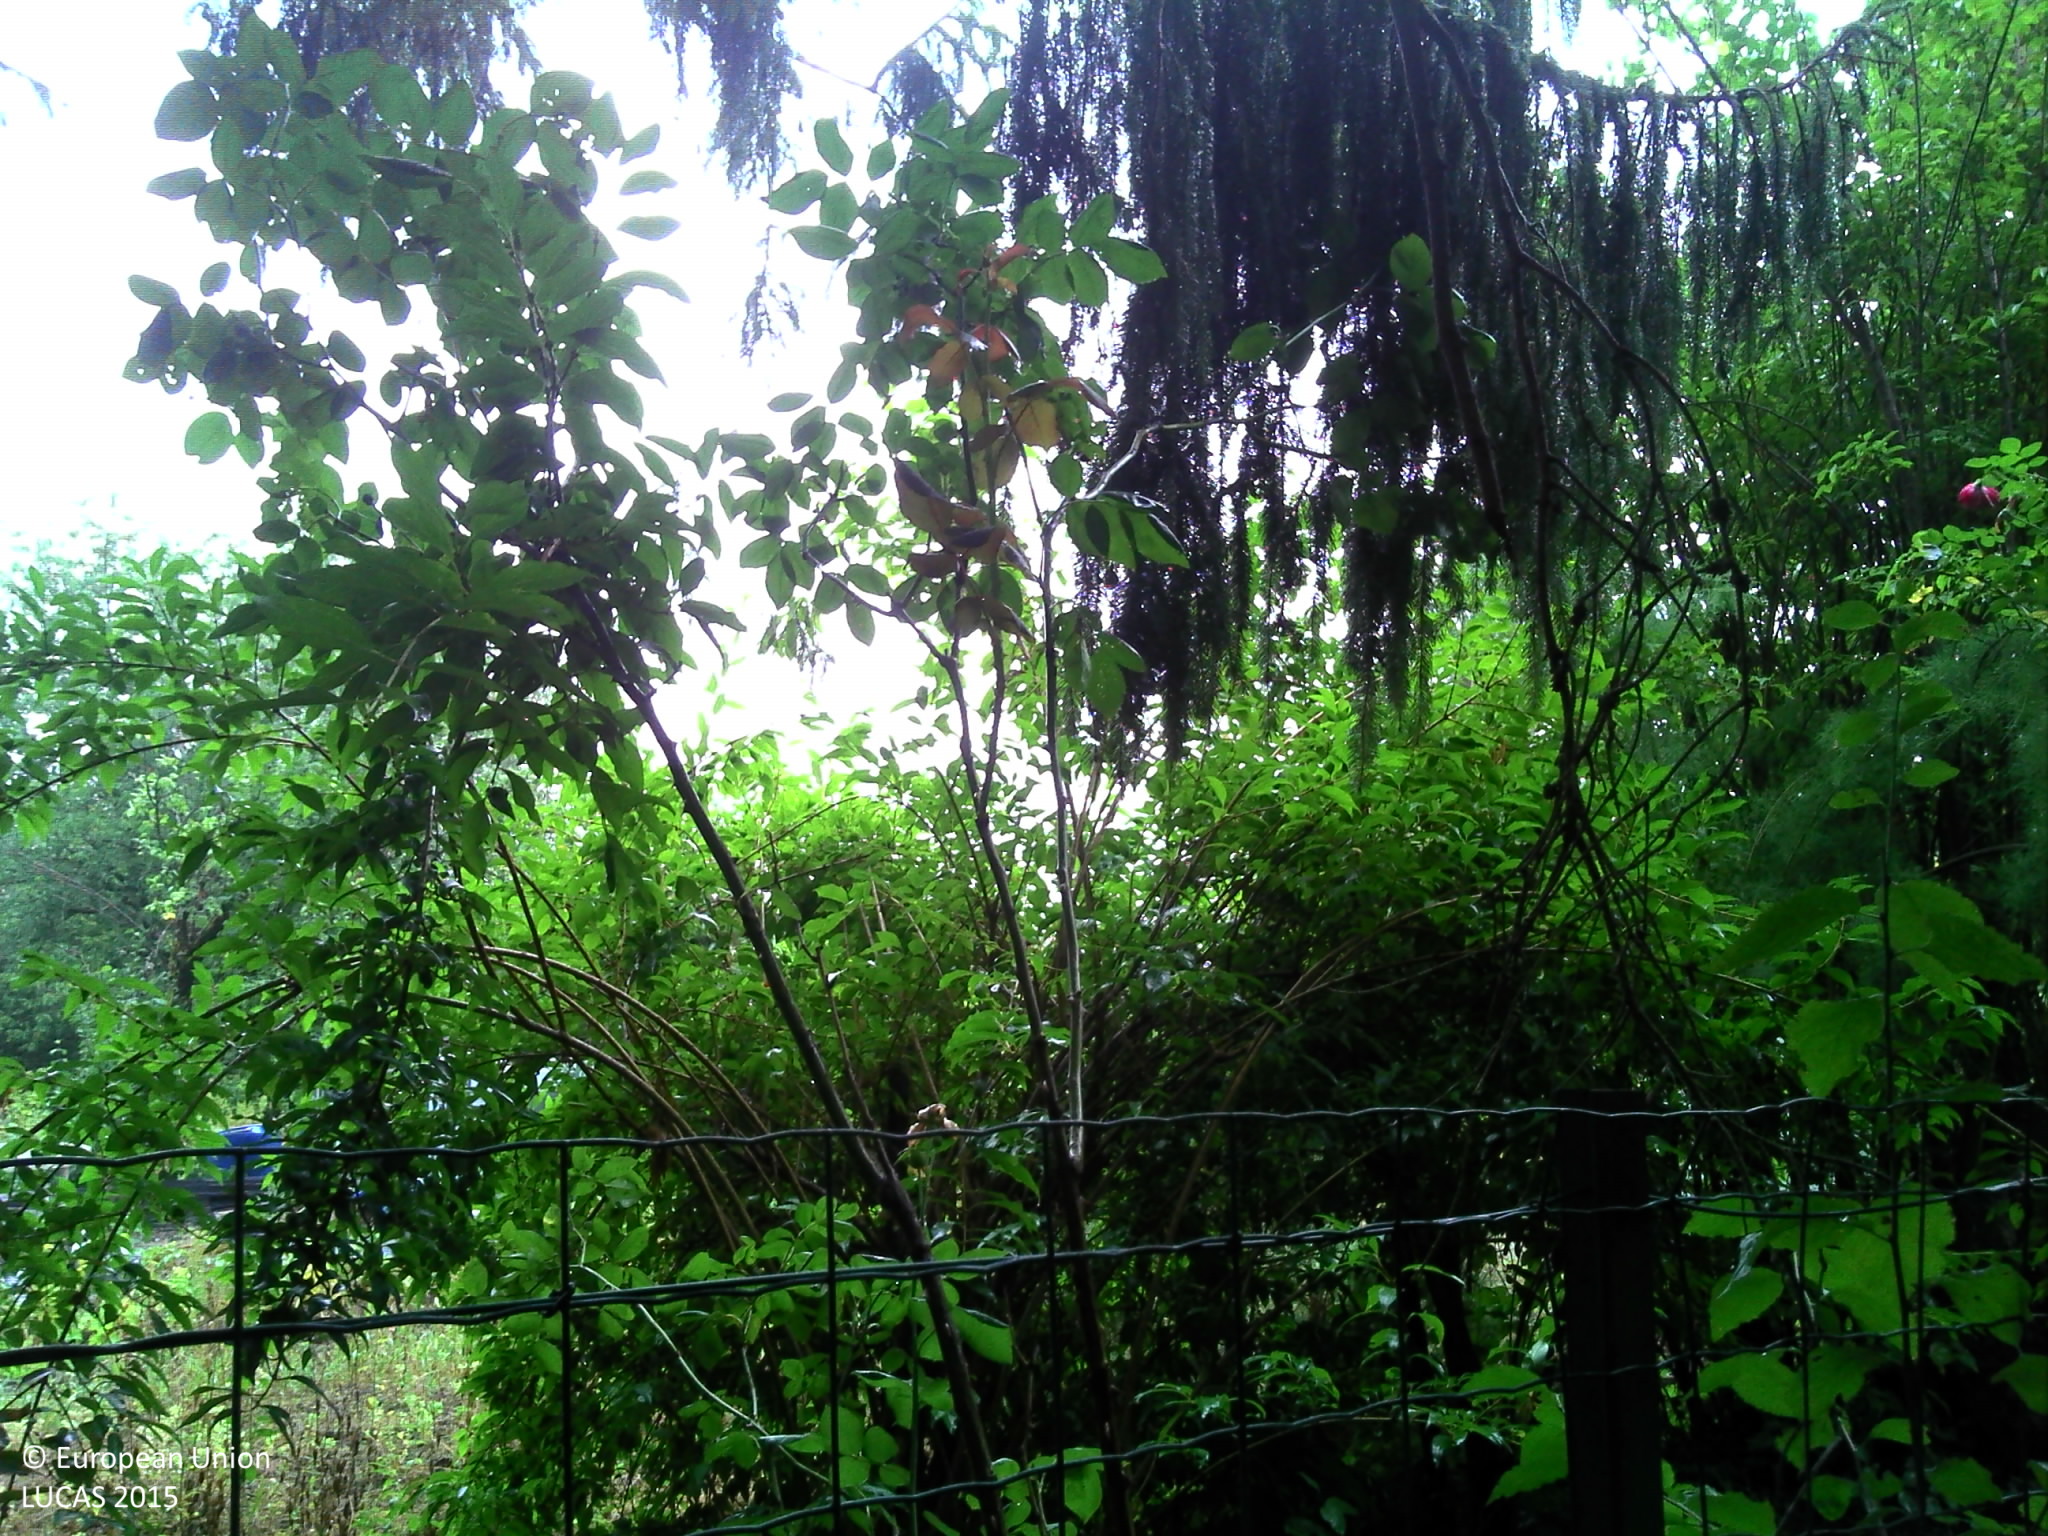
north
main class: Woodland
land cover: Broadleaved woodland
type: mesophytic deciduous forest
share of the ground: > 75 %
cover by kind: broadleaved forest trees 80 %, coniferous forest trees 15 %, herbaceous plants 5 %
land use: Forestry
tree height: > 5 m
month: August
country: FR
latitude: 47.7428
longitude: 7.4008
